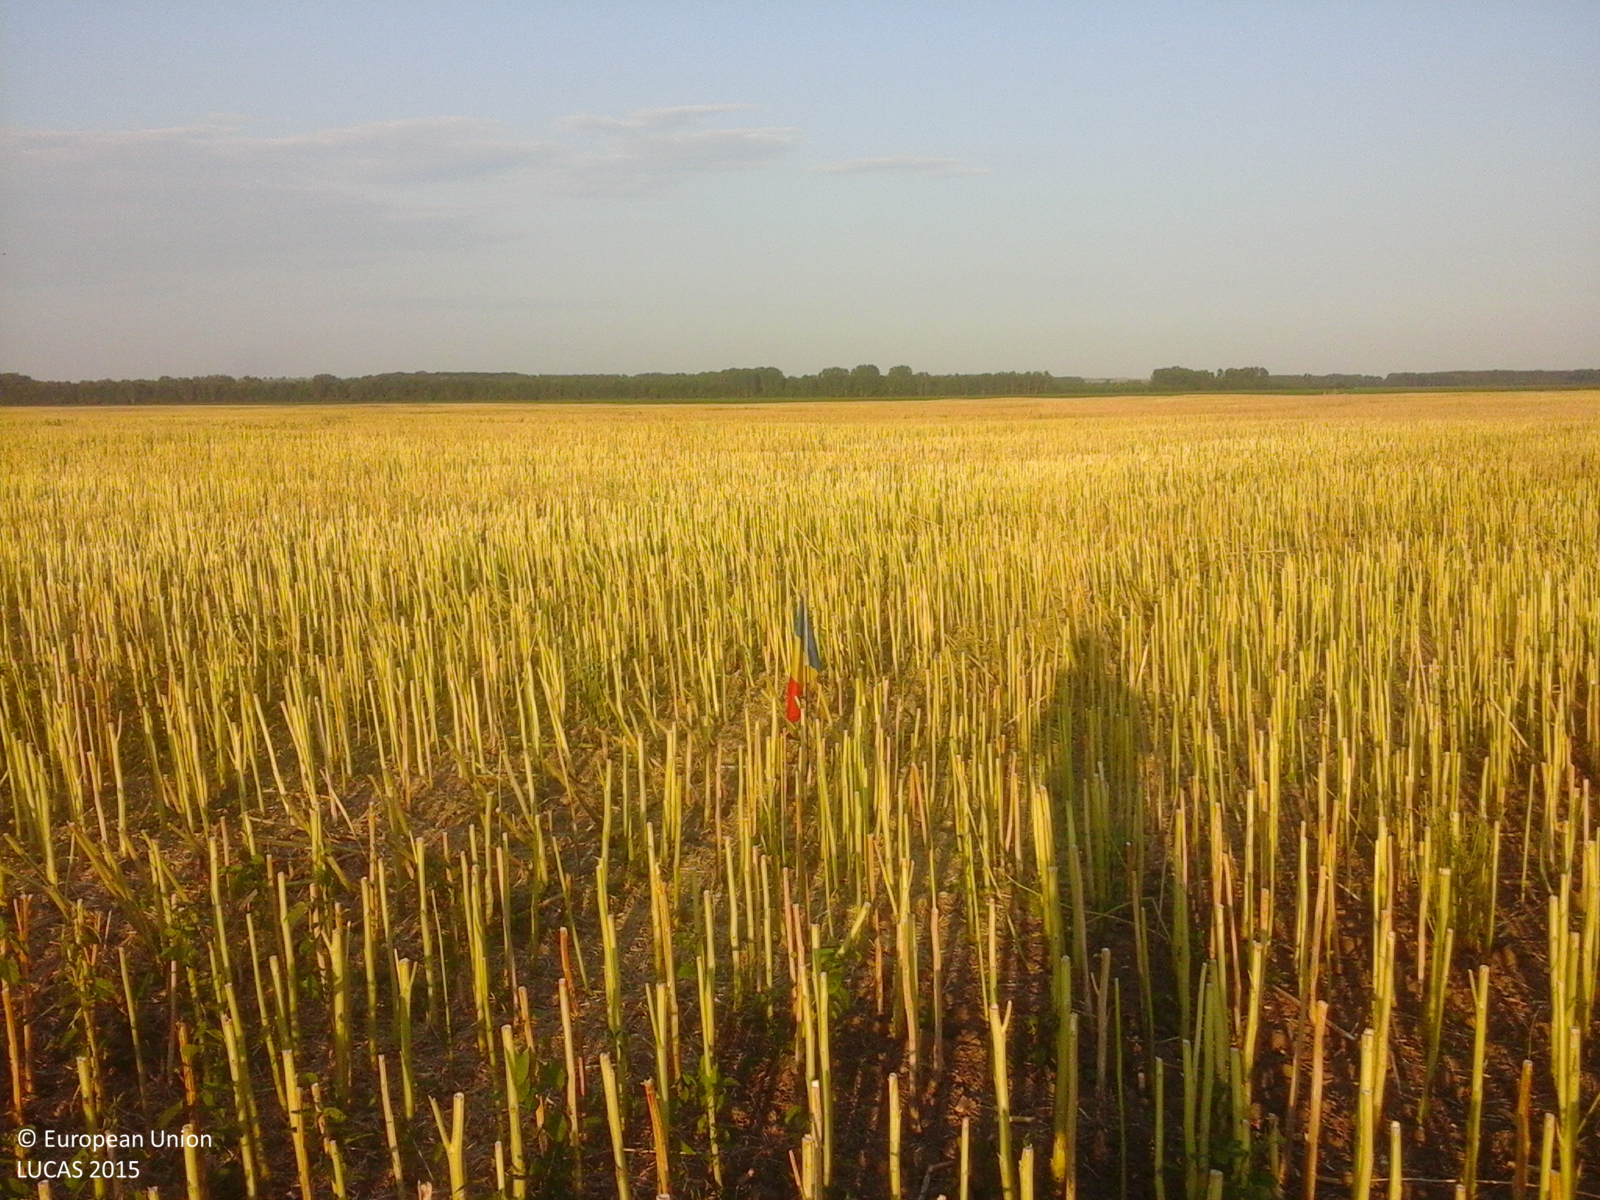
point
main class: Cropland
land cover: Rape and turnip rape
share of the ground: < 10 %
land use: Agriculture (excluding fallow land and kitchen gardens)
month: July
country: RO
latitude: 44.3559
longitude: 24.3315
